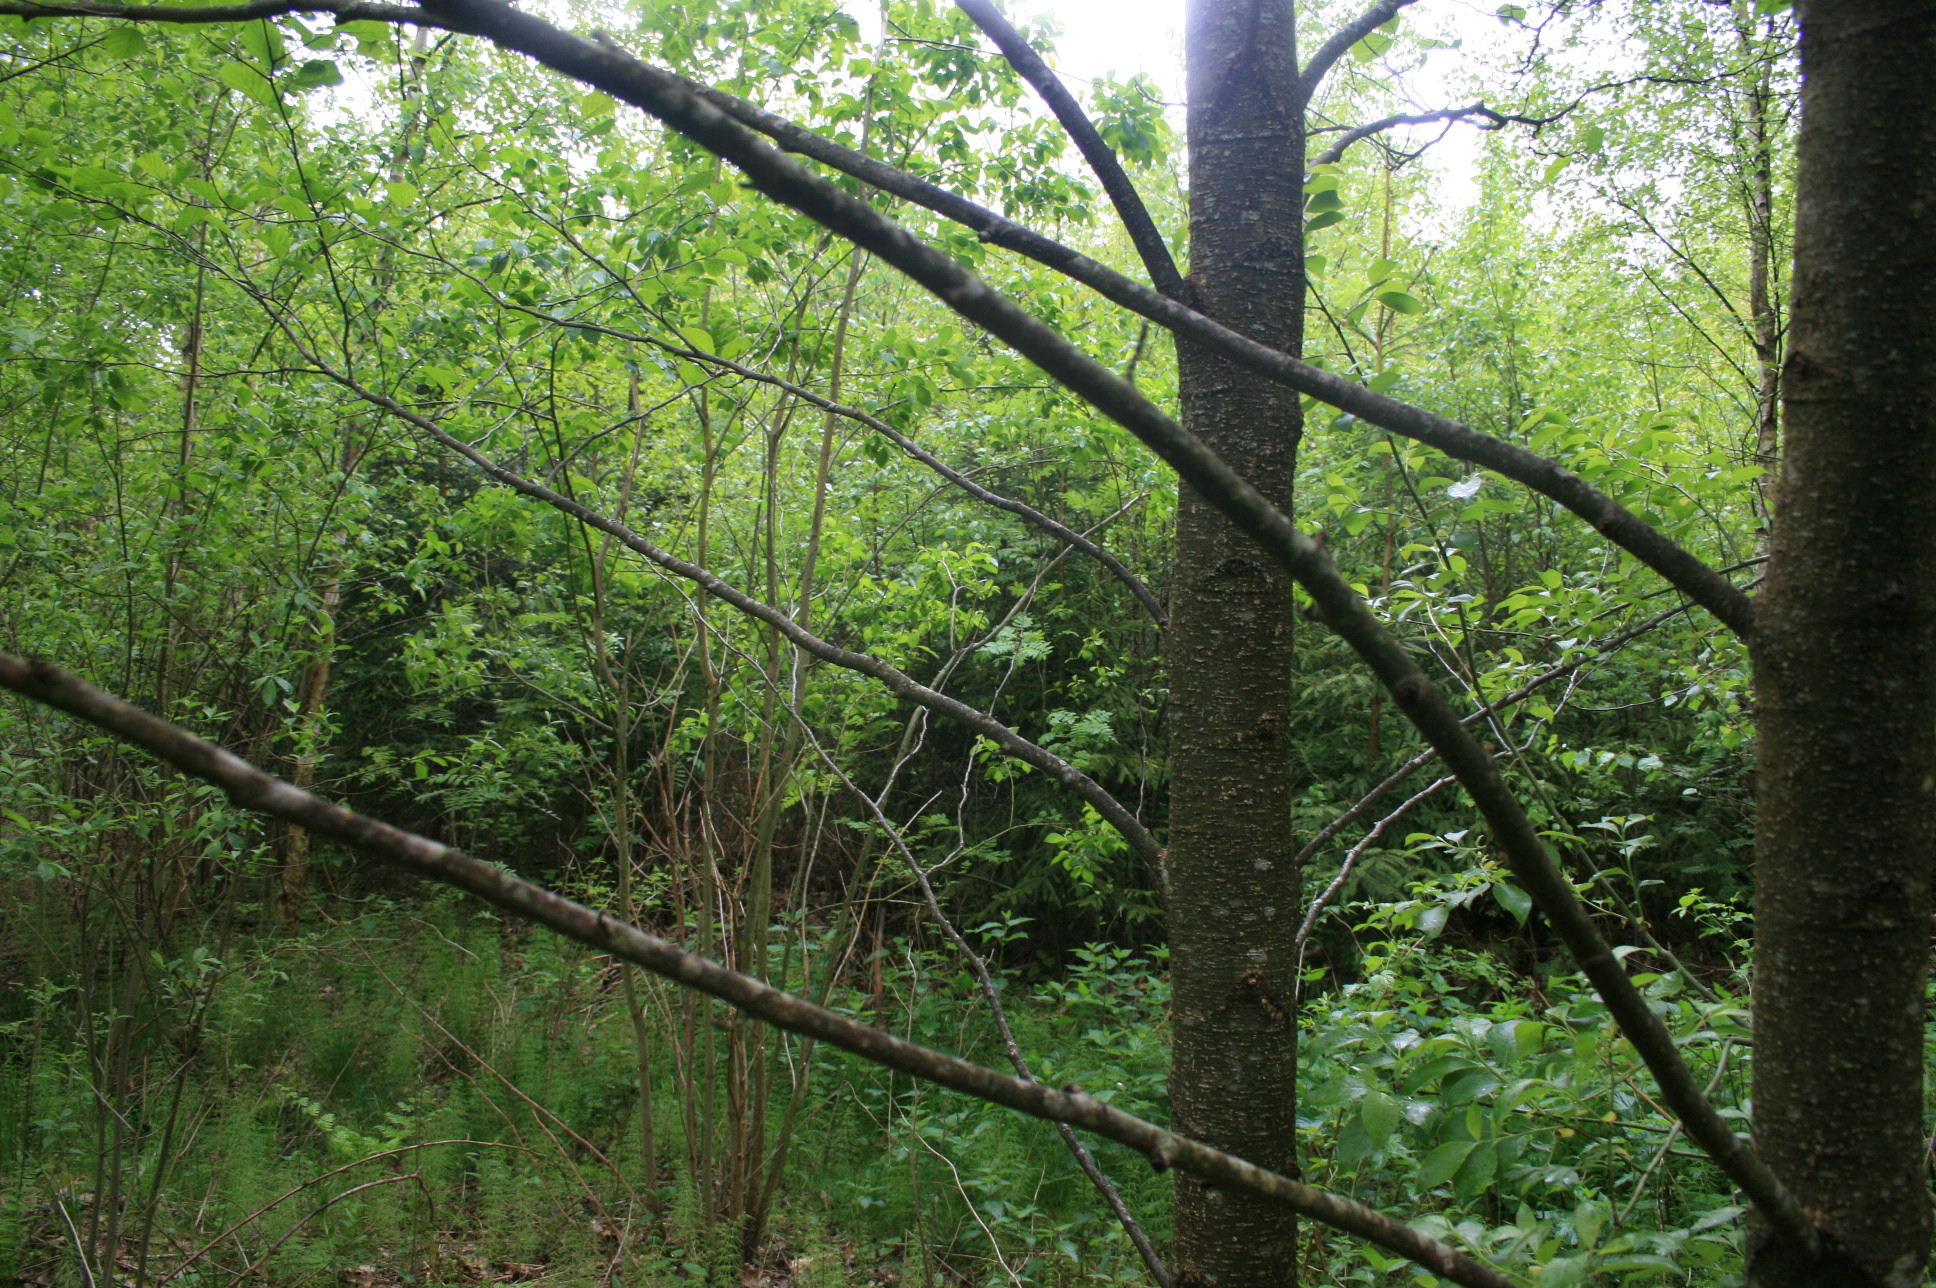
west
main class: Woodland
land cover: Spruce dominated mixed woodland
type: hemiboreal forest and nemoral coniferous forest and mixed broadleaved-coniferous forest
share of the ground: > 75 %
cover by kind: broadleaved forest trees 60 %, coniferous forest trees 30 %, herbaceous plants 10 %
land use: Forestry
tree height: > 5 m
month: May
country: LT
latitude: 55.8543
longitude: 21.8549
